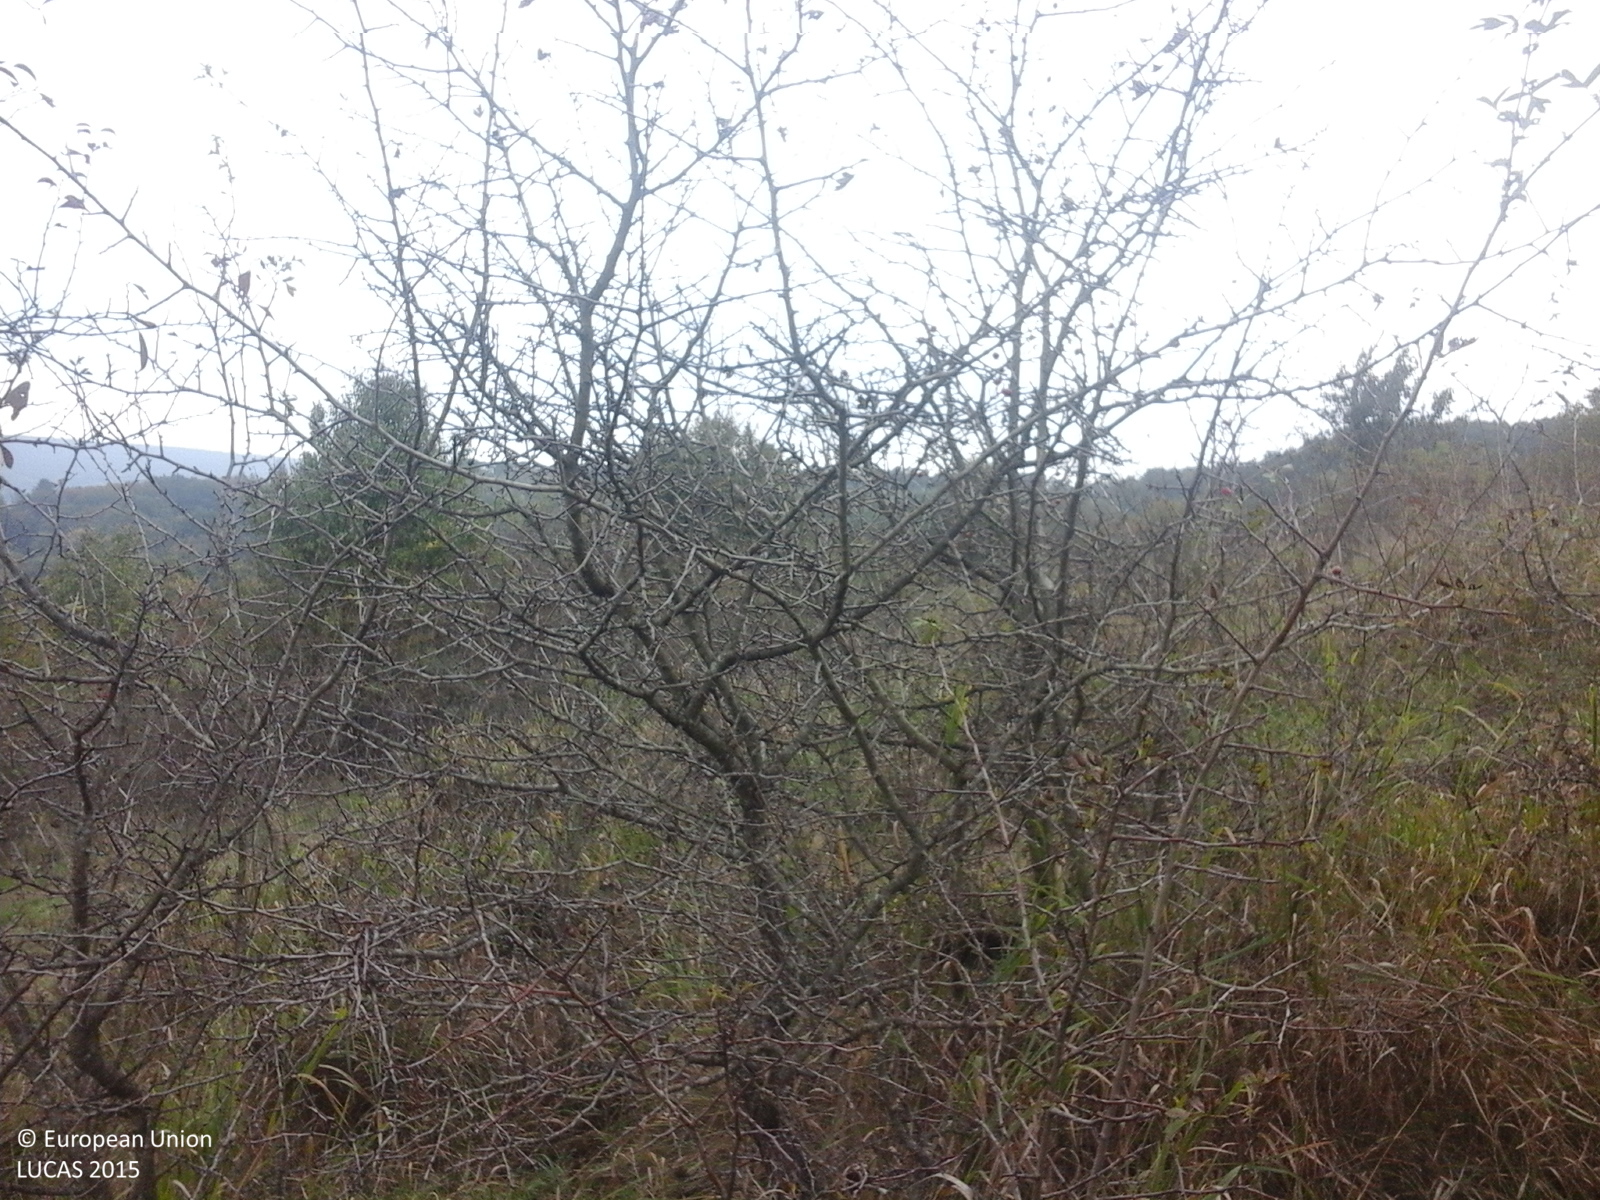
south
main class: Shrubland
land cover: Shrubland with sparse tree cover
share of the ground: > 75 %
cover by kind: shrubs 60 %, herbaceous plants 35 %, broadleaved forest trees 5 %
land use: Fallow land
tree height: < 5 m
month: October
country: RO
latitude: 46.1081
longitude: 25.0119
